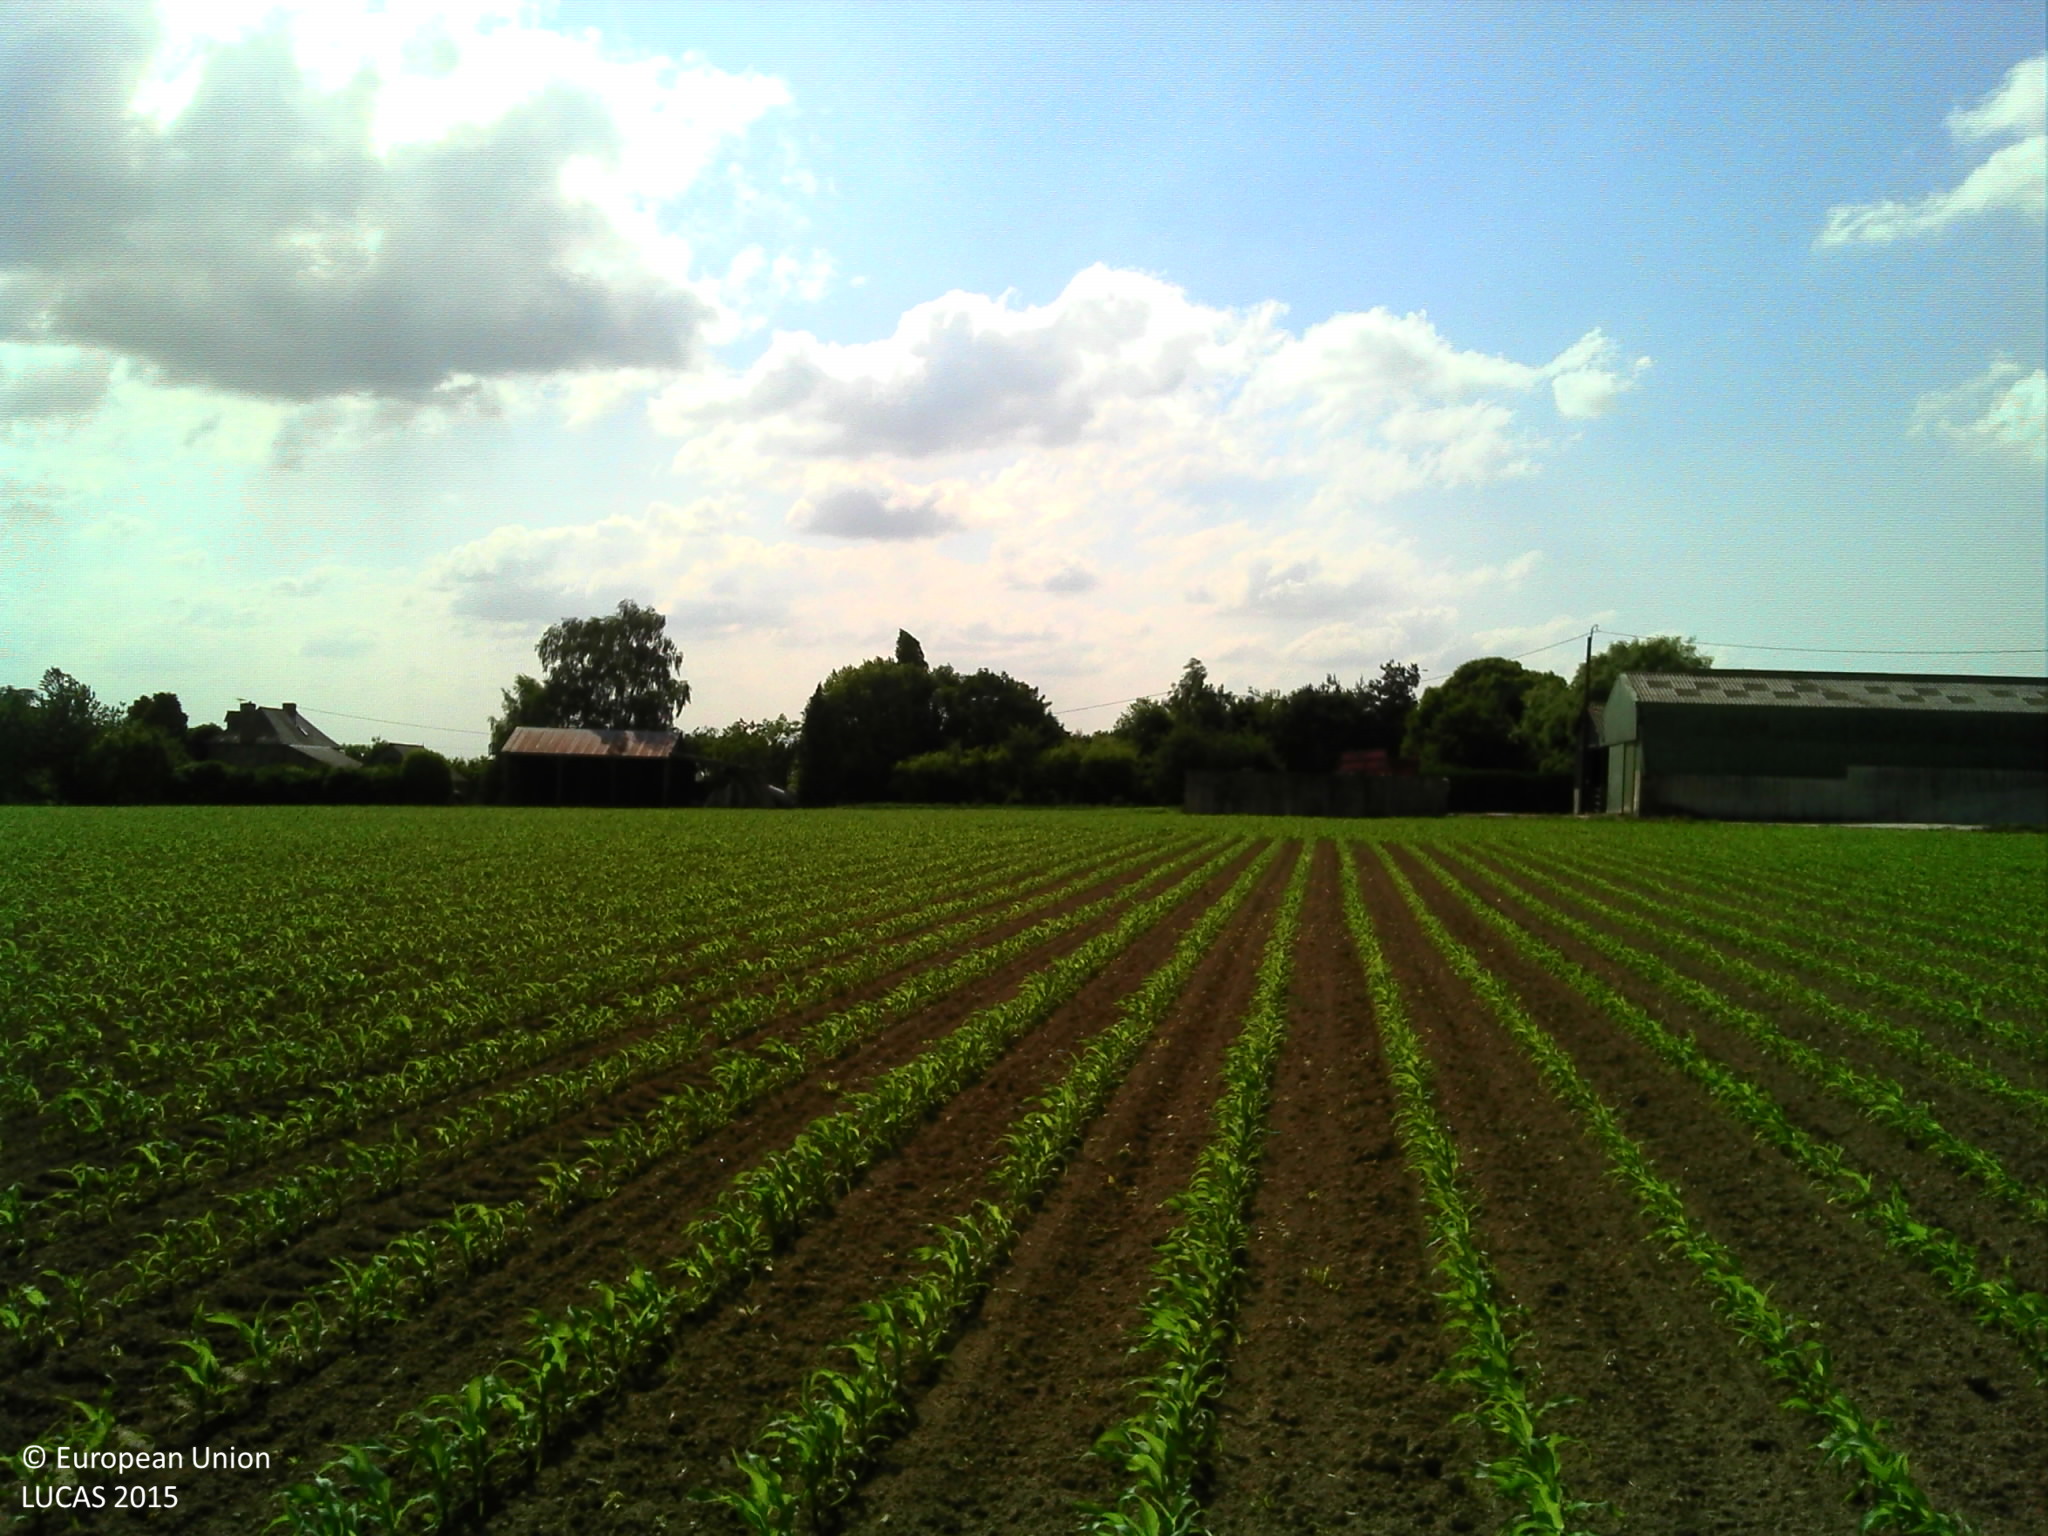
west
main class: Cropland
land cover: Maize
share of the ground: 10 - 25 %
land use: Agriculture (excluding fallow land and kitchen gardens)
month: June
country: FR
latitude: 48.2372
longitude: -1.1496
